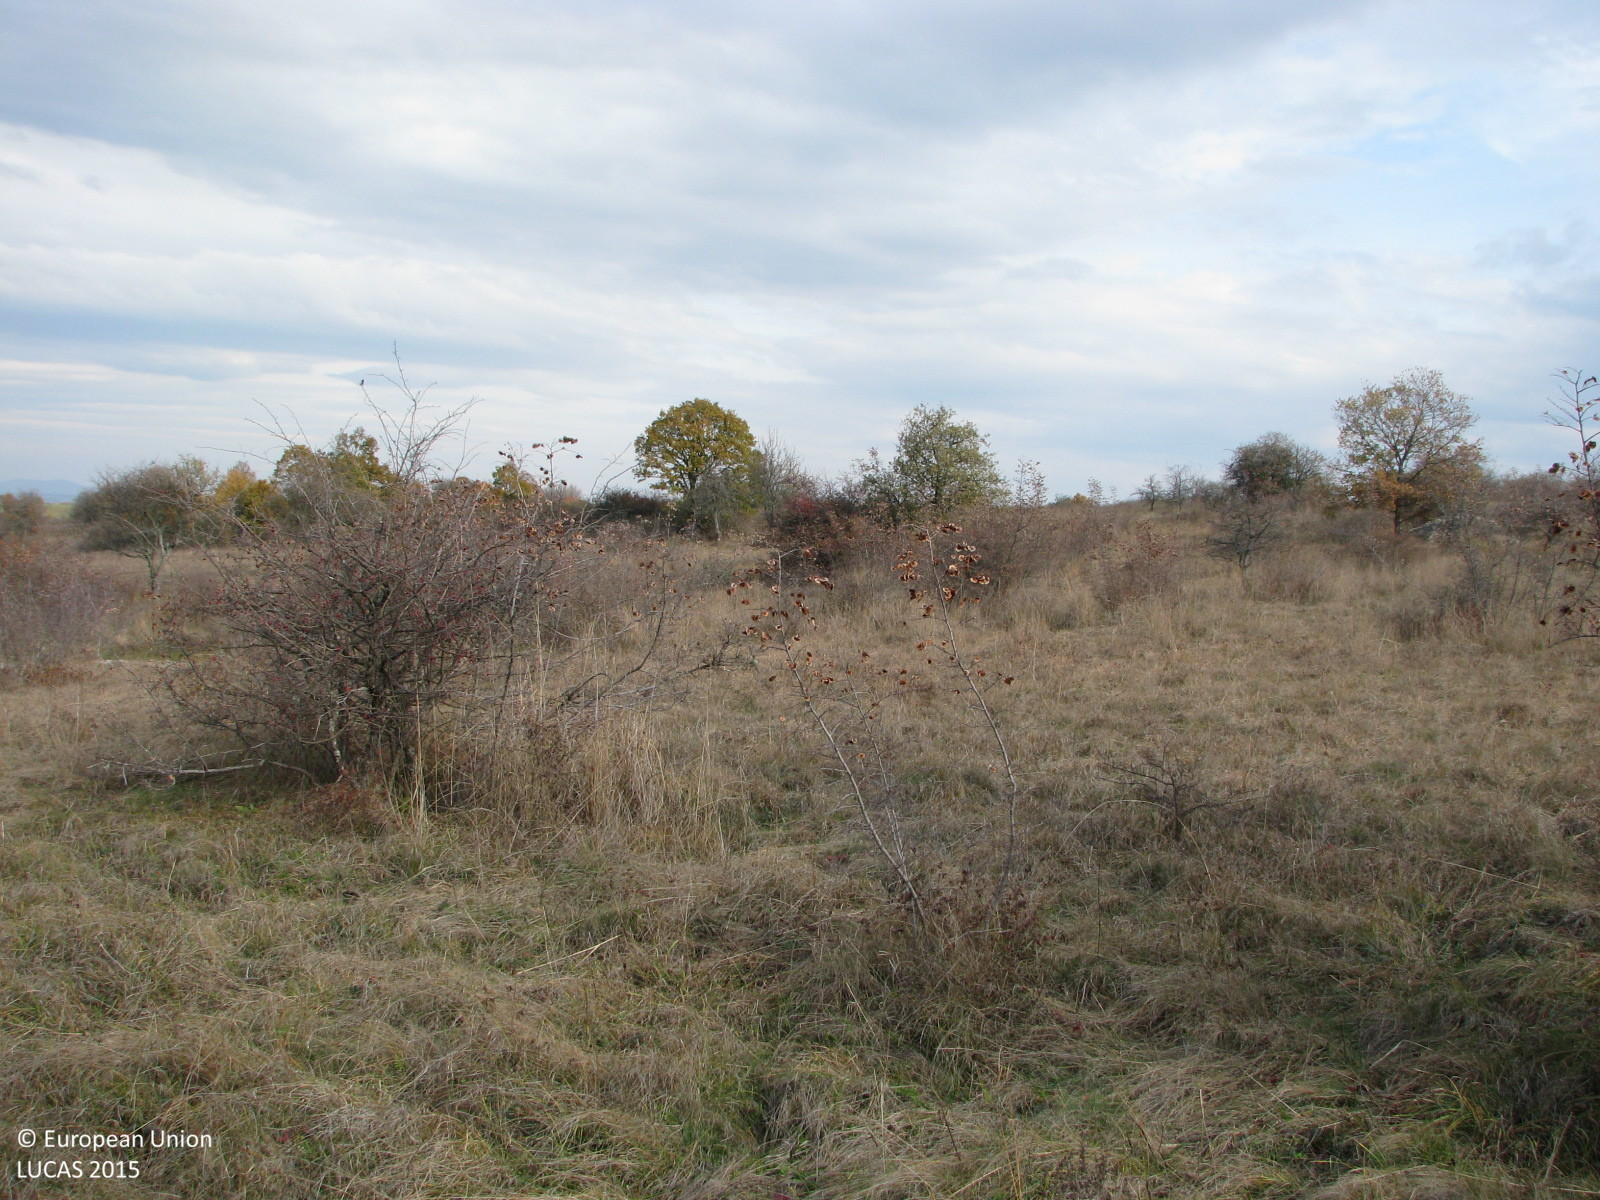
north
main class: Grassland
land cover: Grassland with sparse tree/shrub cover
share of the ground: > 75 %
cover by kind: herbaceous plants 85 %, shrubs 10 %, broadleaved forest trees 5 %
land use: Agriculture (excluding fallow land and kitchen gardens)
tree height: < 5 m
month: November
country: BG
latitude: 41.9417
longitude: 26.4516
